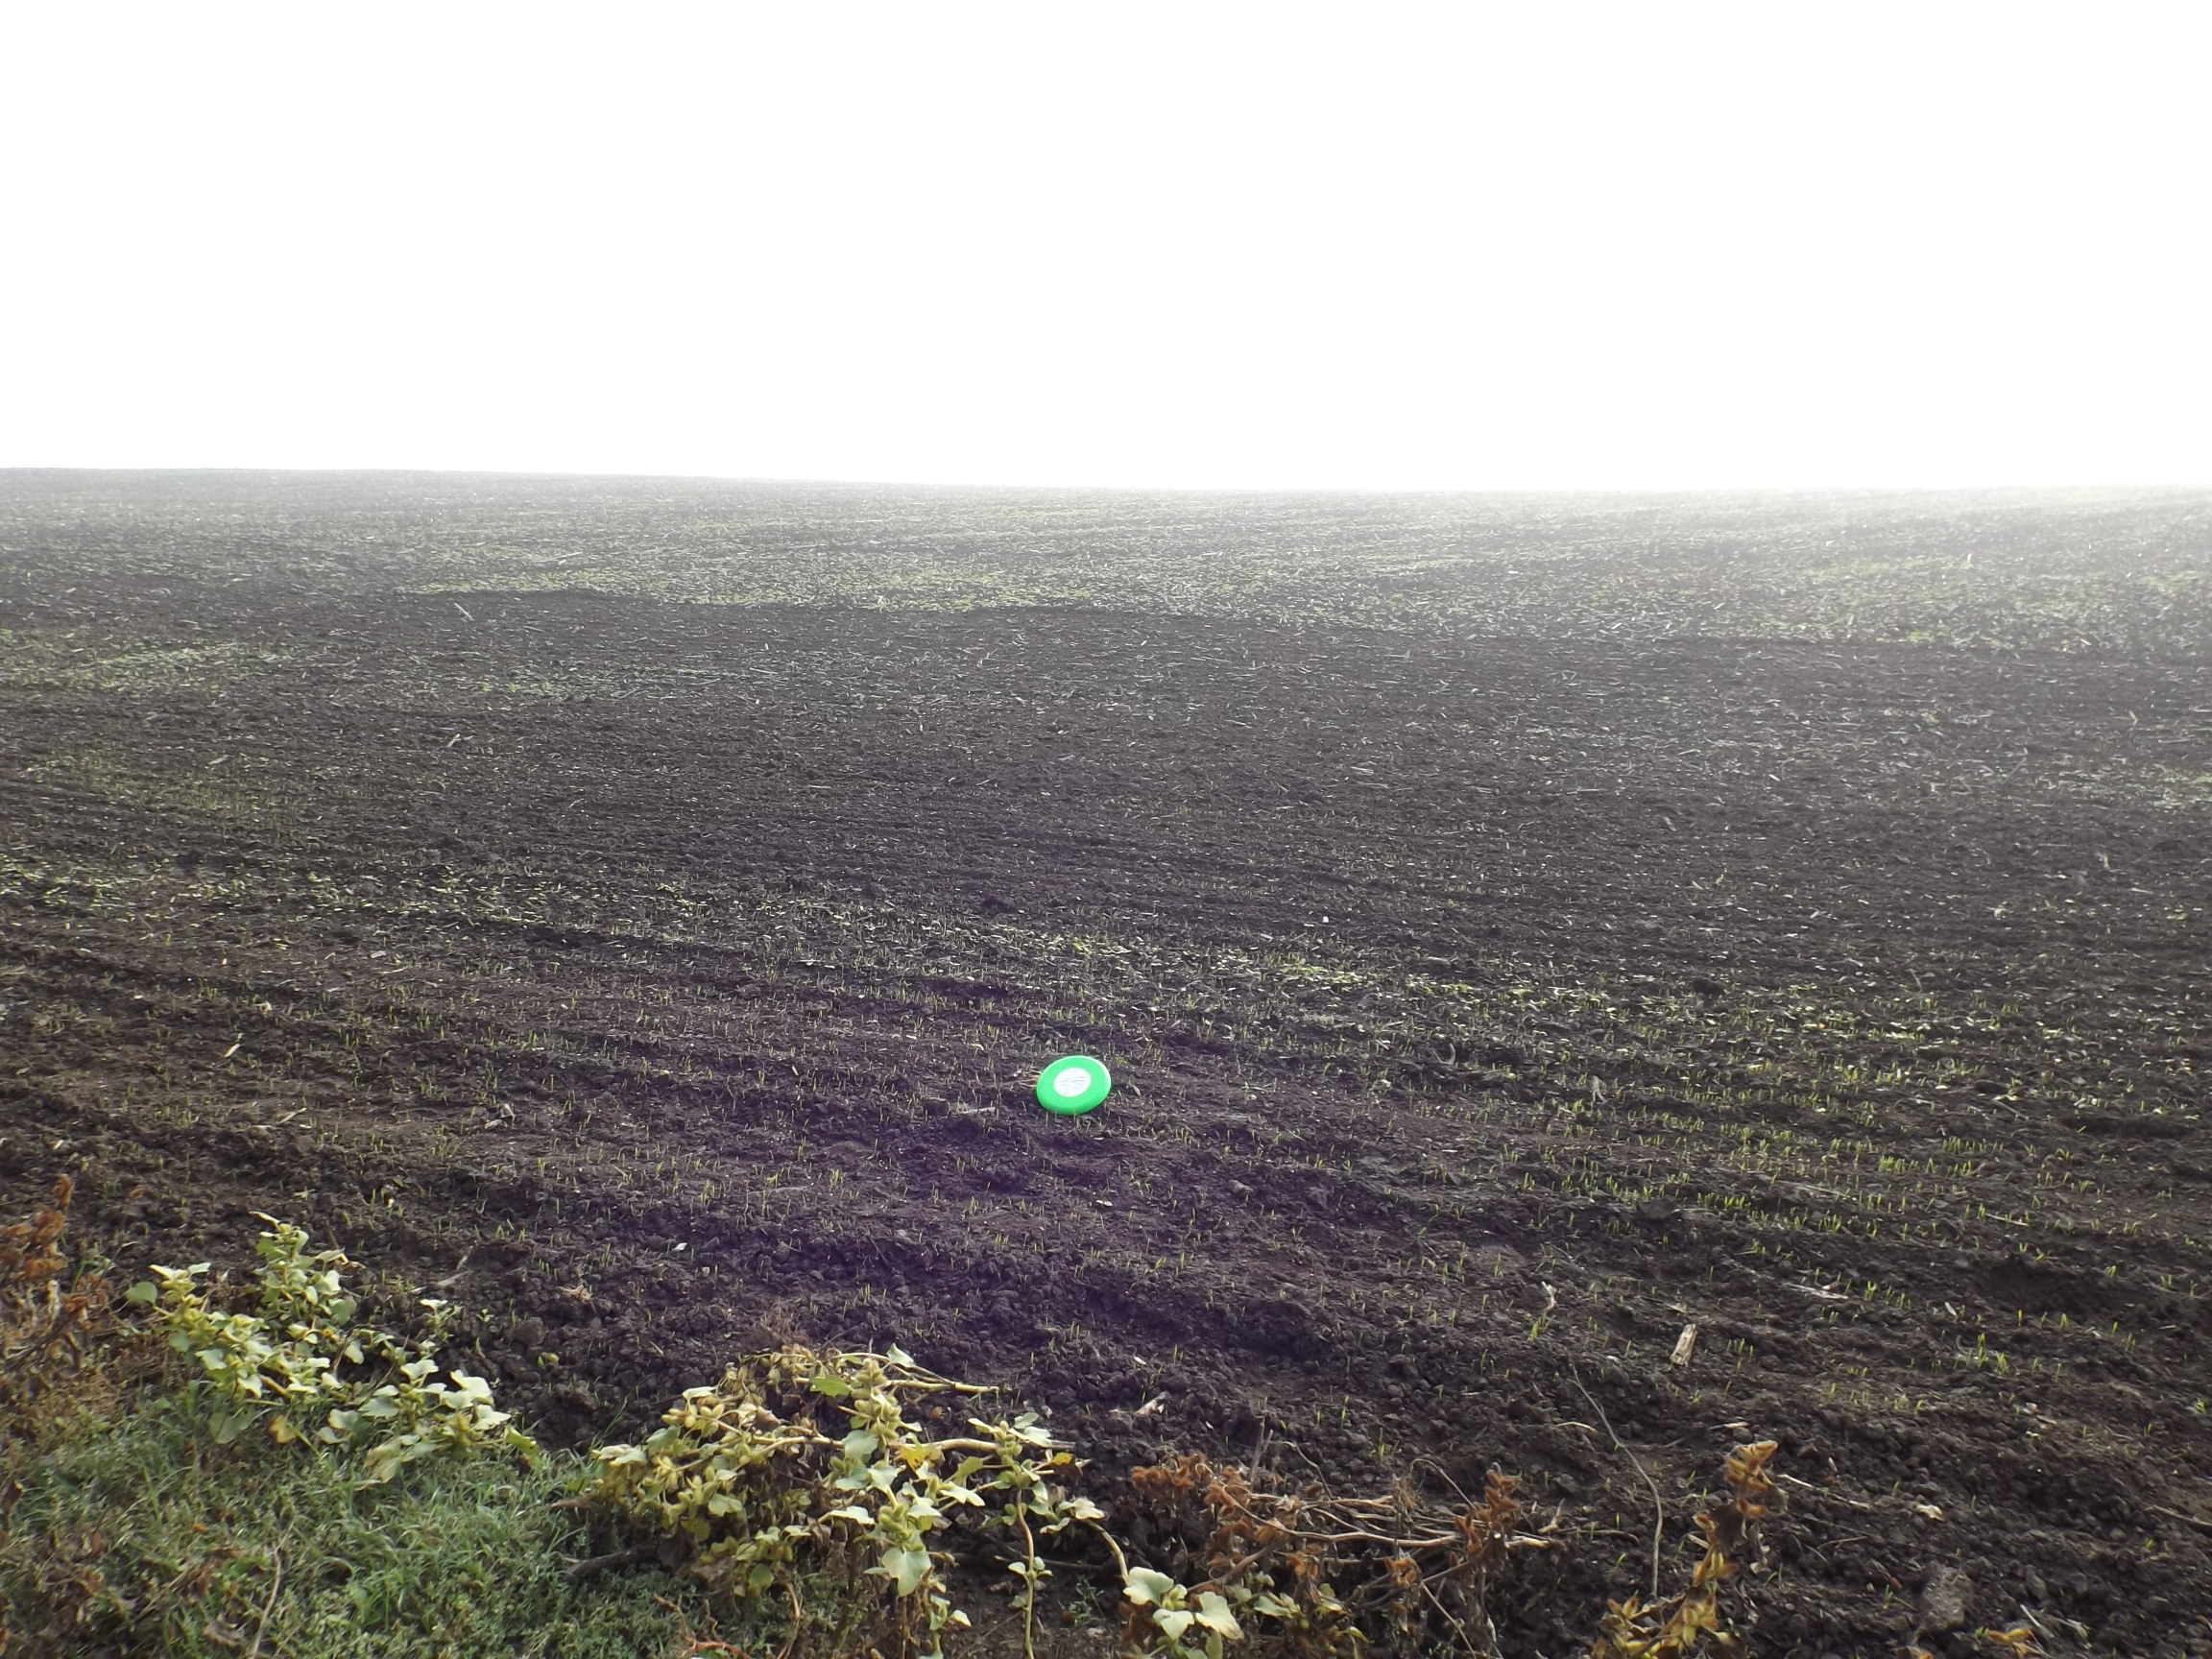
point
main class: Cropland
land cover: Sunflower
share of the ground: < 10 %
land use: Agriculture (excluding fallow land and kitchen gardens)
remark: Harvested field
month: October
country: BG
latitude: 43.1639
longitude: 27.2784
